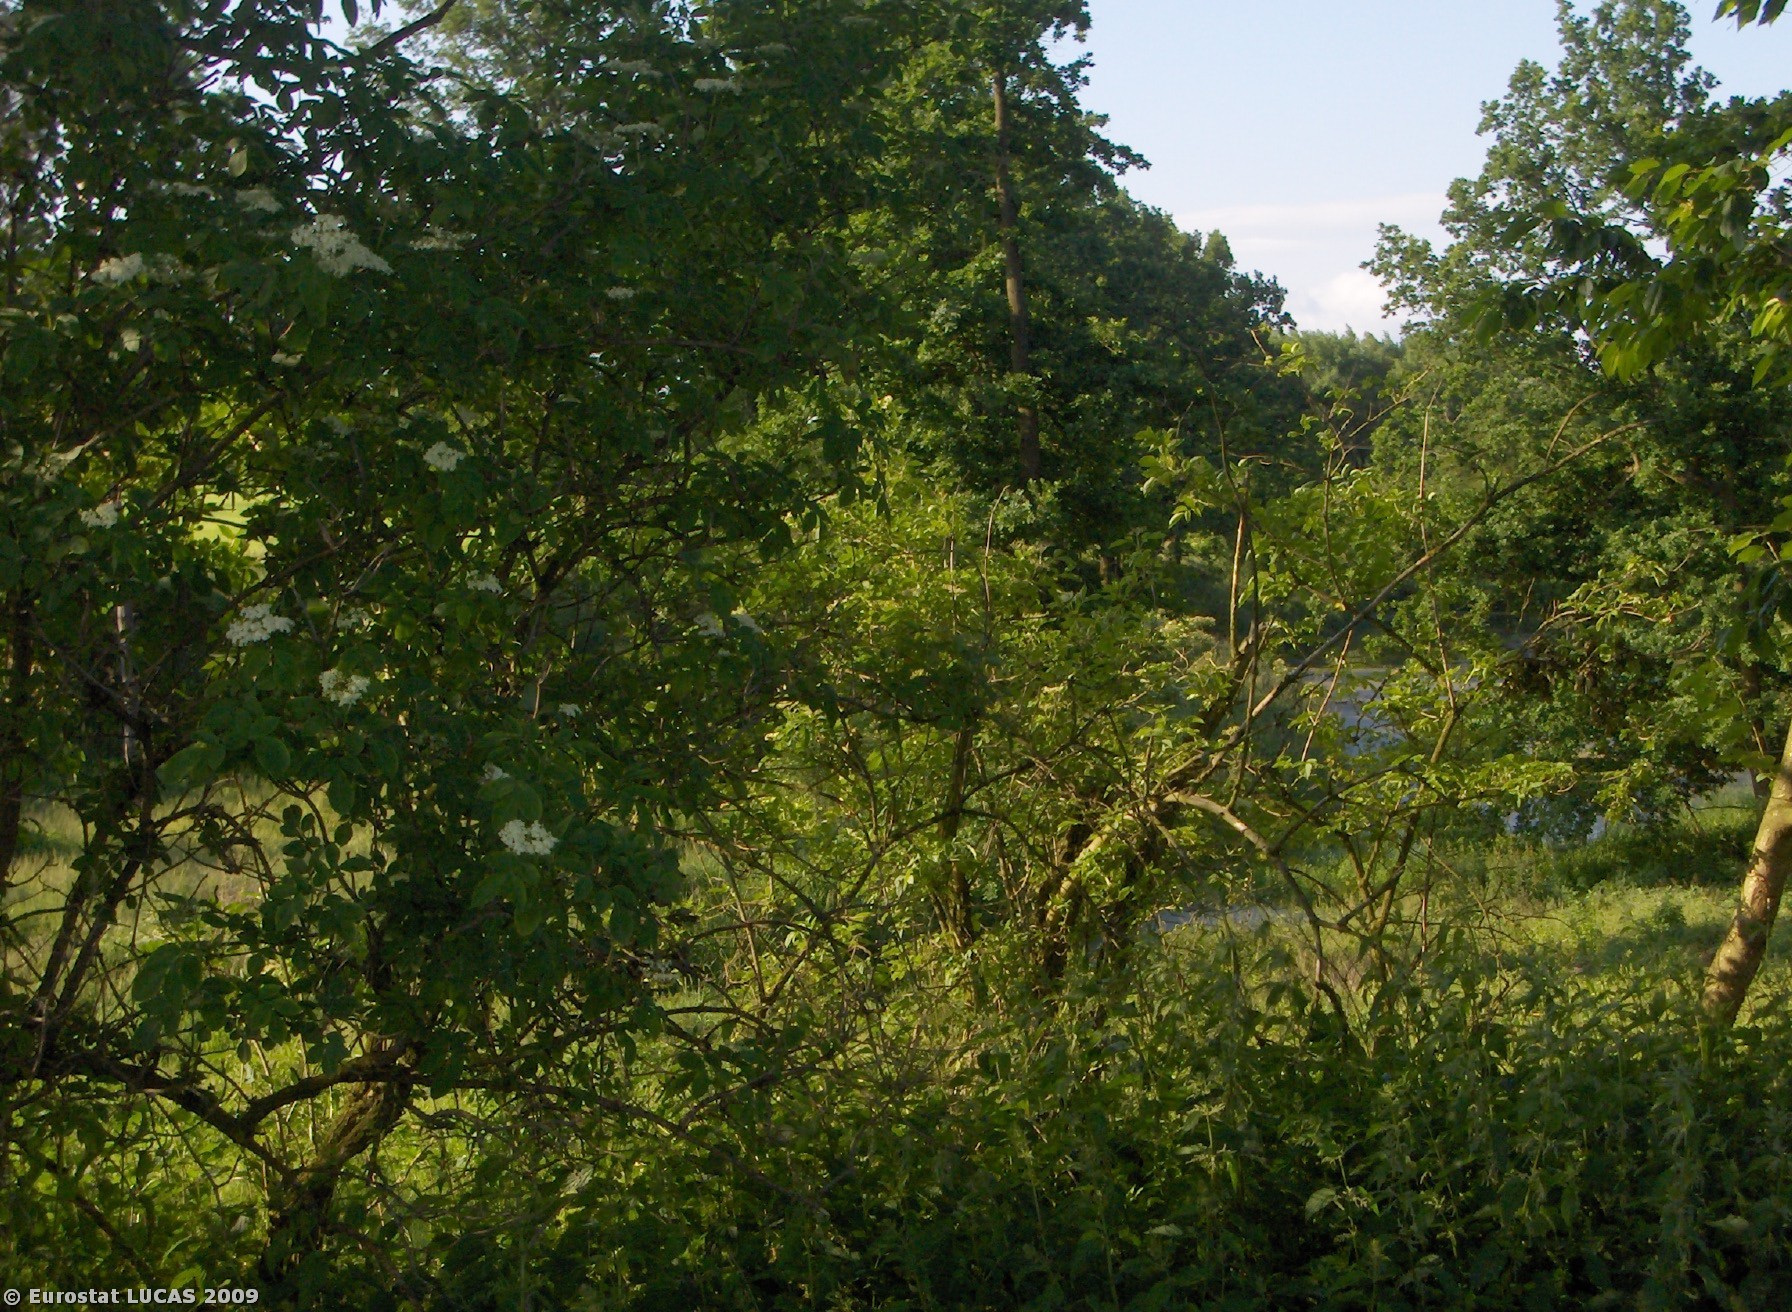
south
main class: Cropland
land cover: Barley
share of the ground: > 75 %
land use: Agriculture (excluding fallow land and kitchen gardens)
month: June
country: CZ
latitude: 49.1658
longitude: 14.3211
